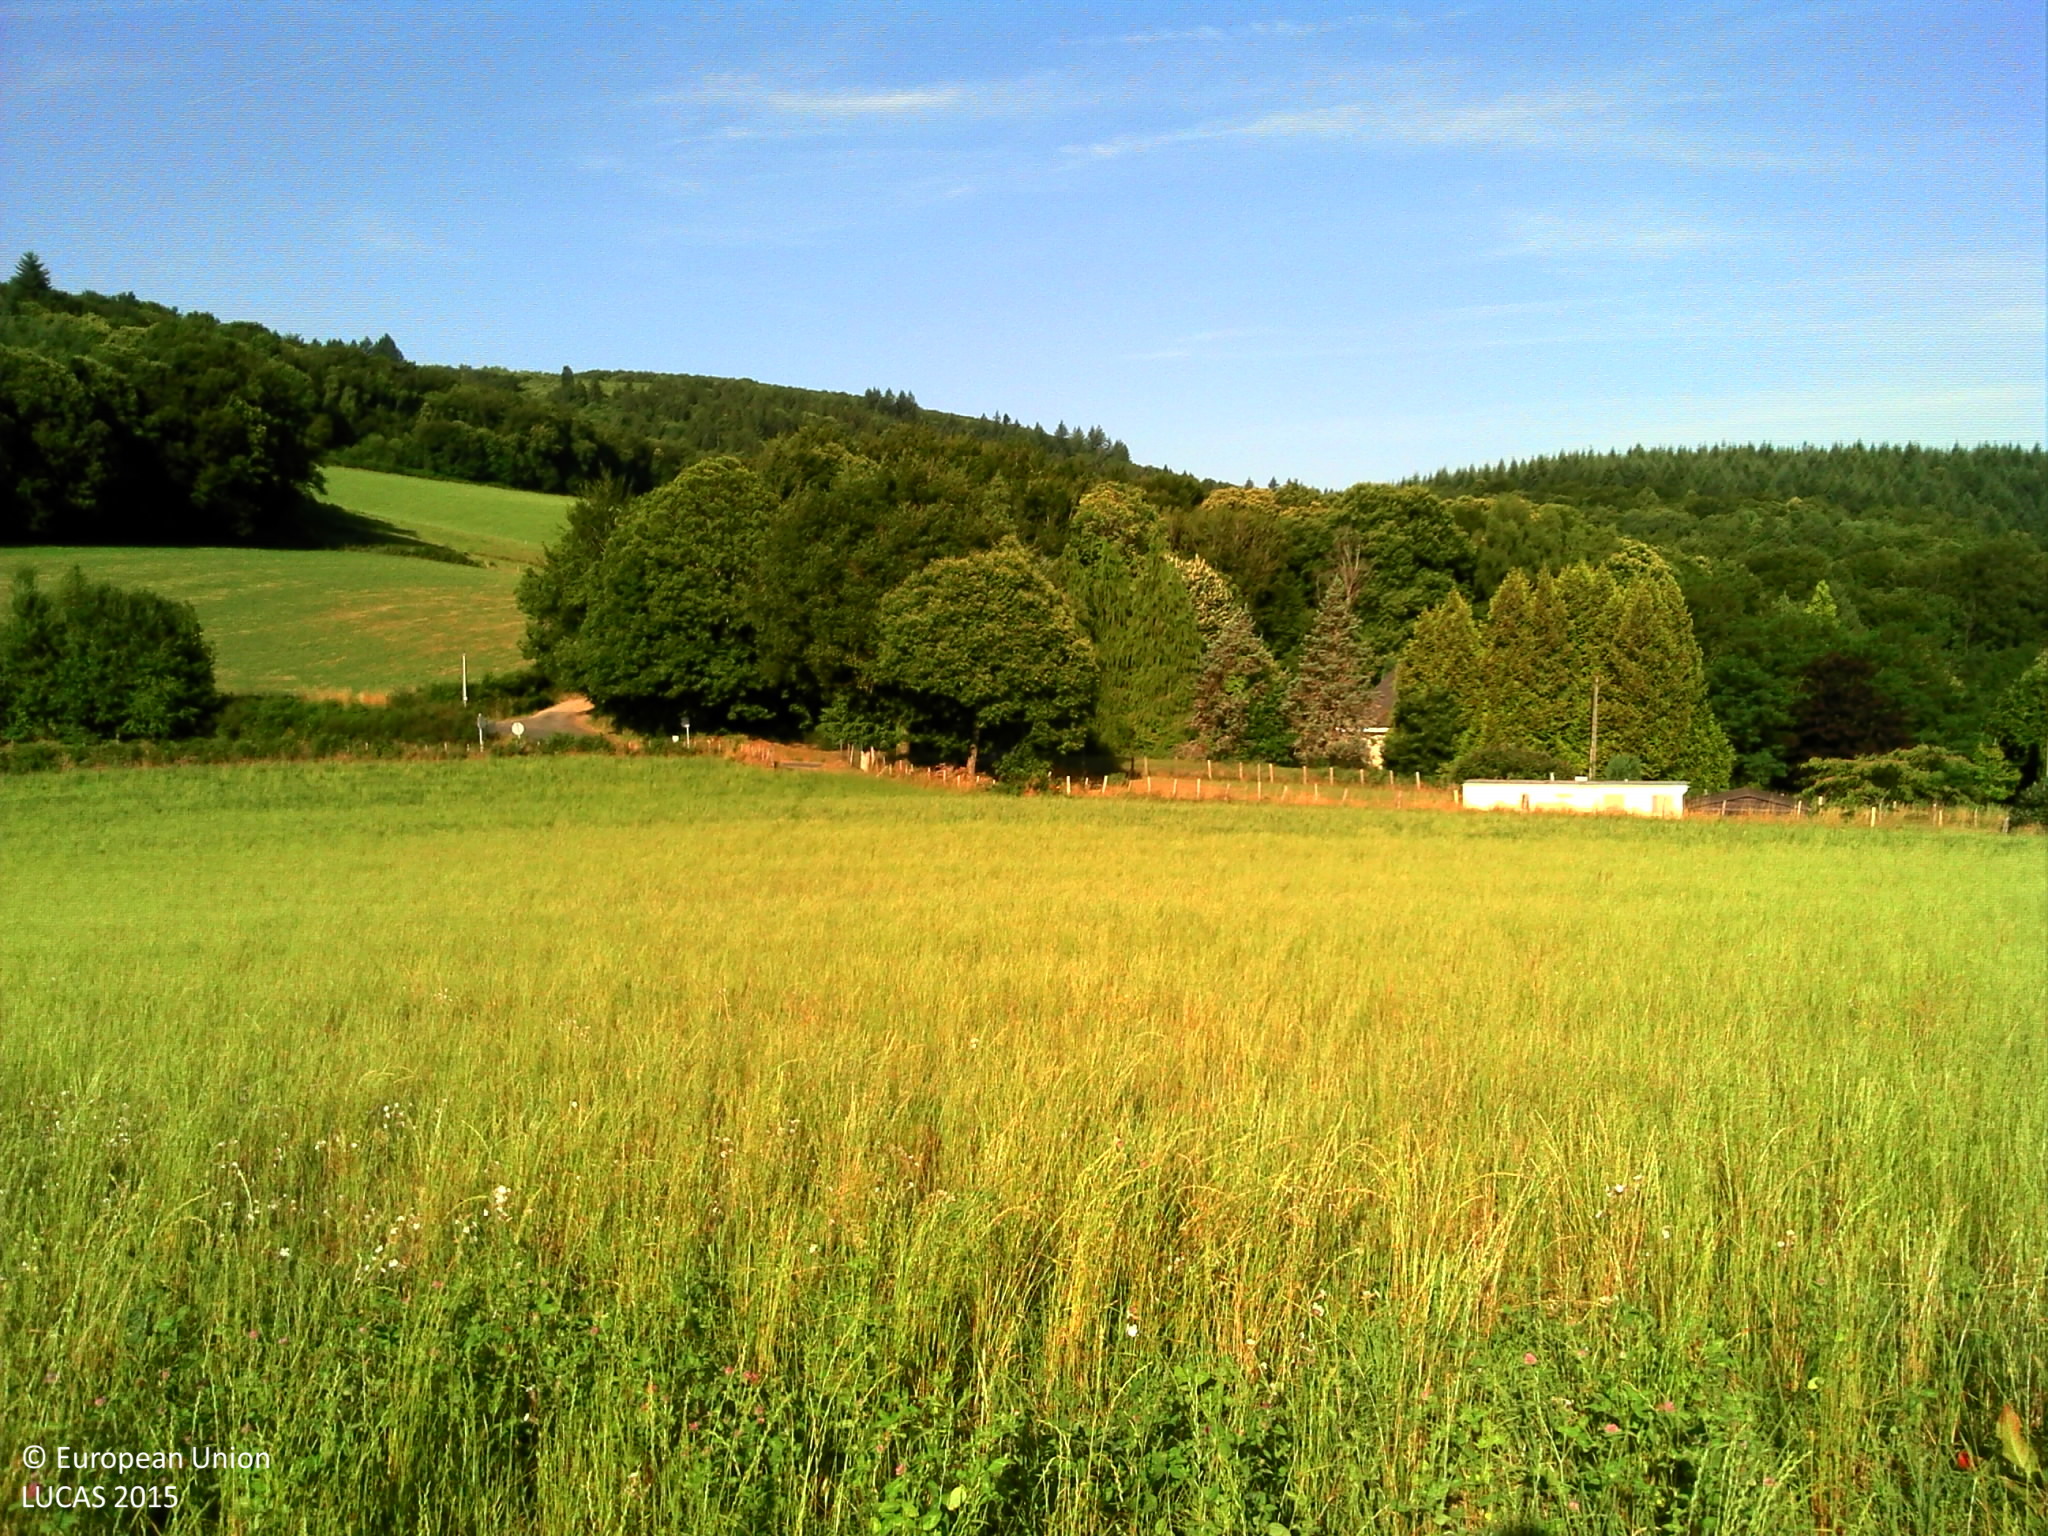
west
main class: Cropland
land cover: Temporary grasslands
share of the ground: 50 - 75 %
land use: Agriculture (excluding fallow land and kitchen gardens)
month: July
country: FR
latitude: 45.7250
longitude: 1.7580
